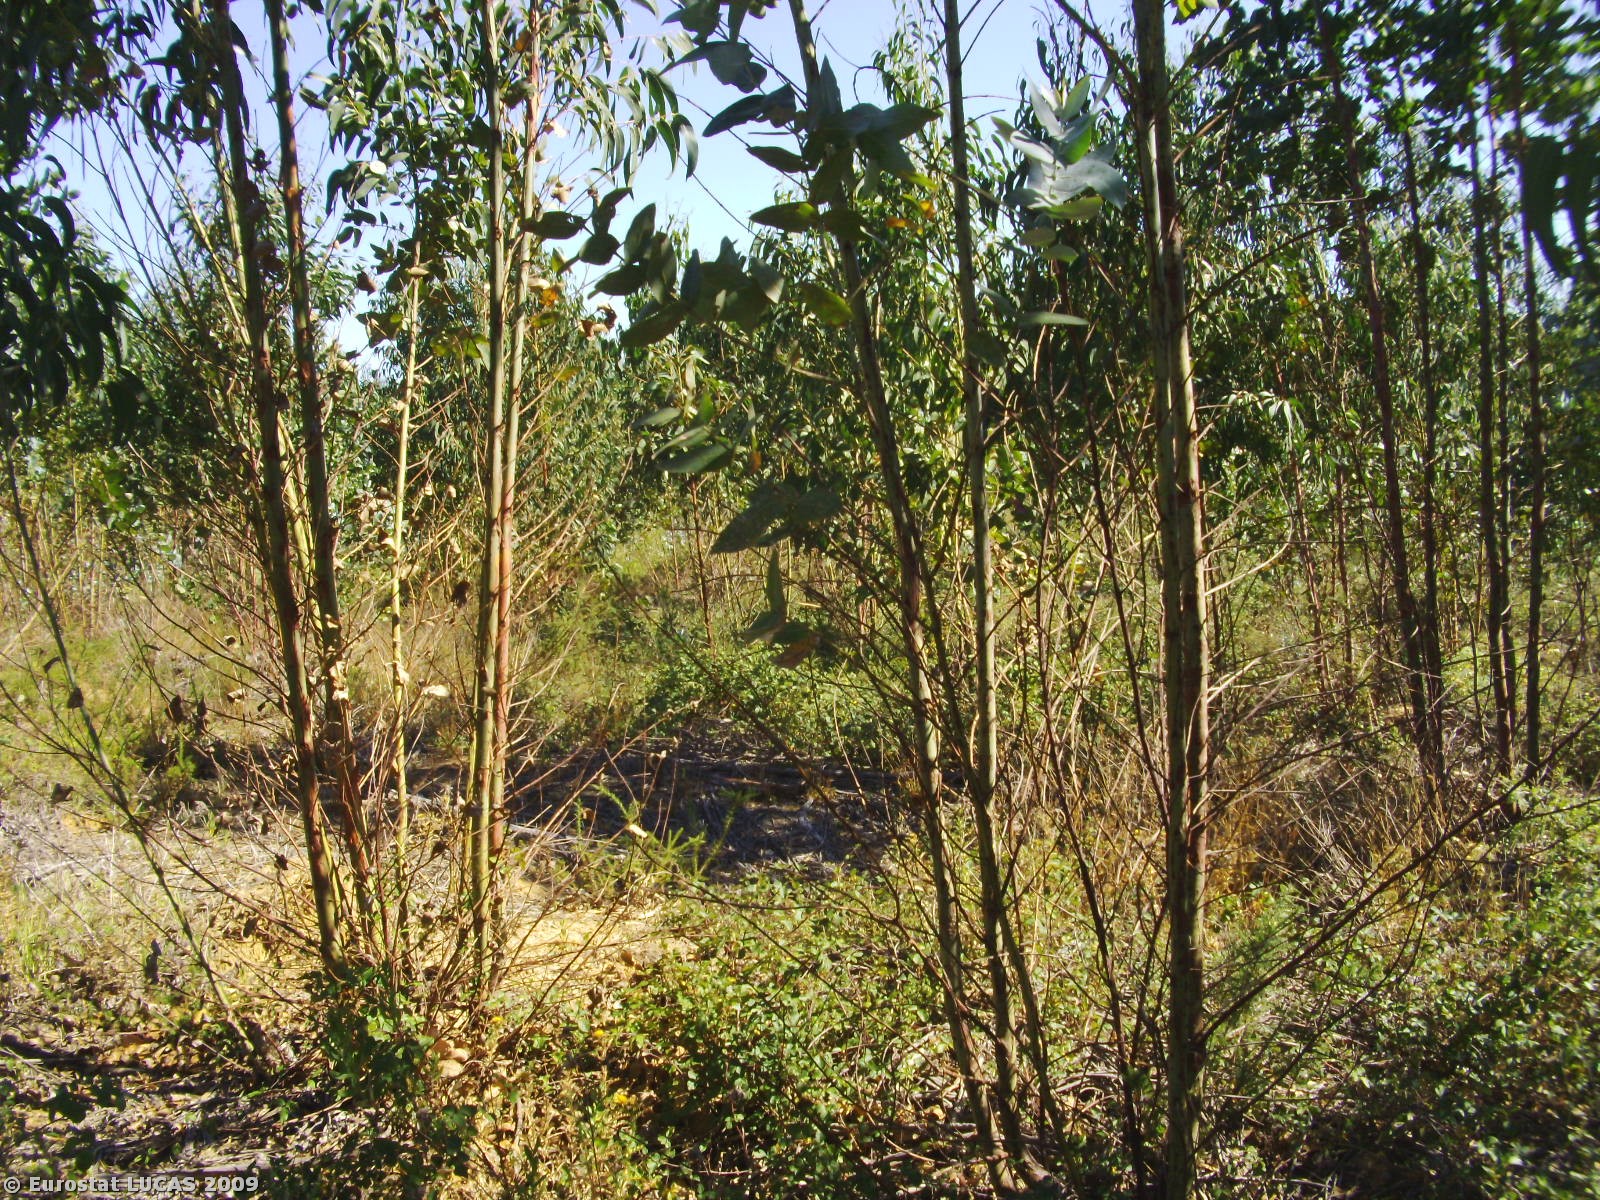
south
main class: Woodland
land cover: Broadleaved woodland
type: plantations and self-sown exotic forest
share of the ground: 50 - 75 %
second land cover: Shrubland with sparse tree cover
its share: 25 - 50 %
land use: Forestry
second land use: Unused
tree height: > 5 m
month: July
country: PT
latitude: 39.1685
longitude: -9.0041
